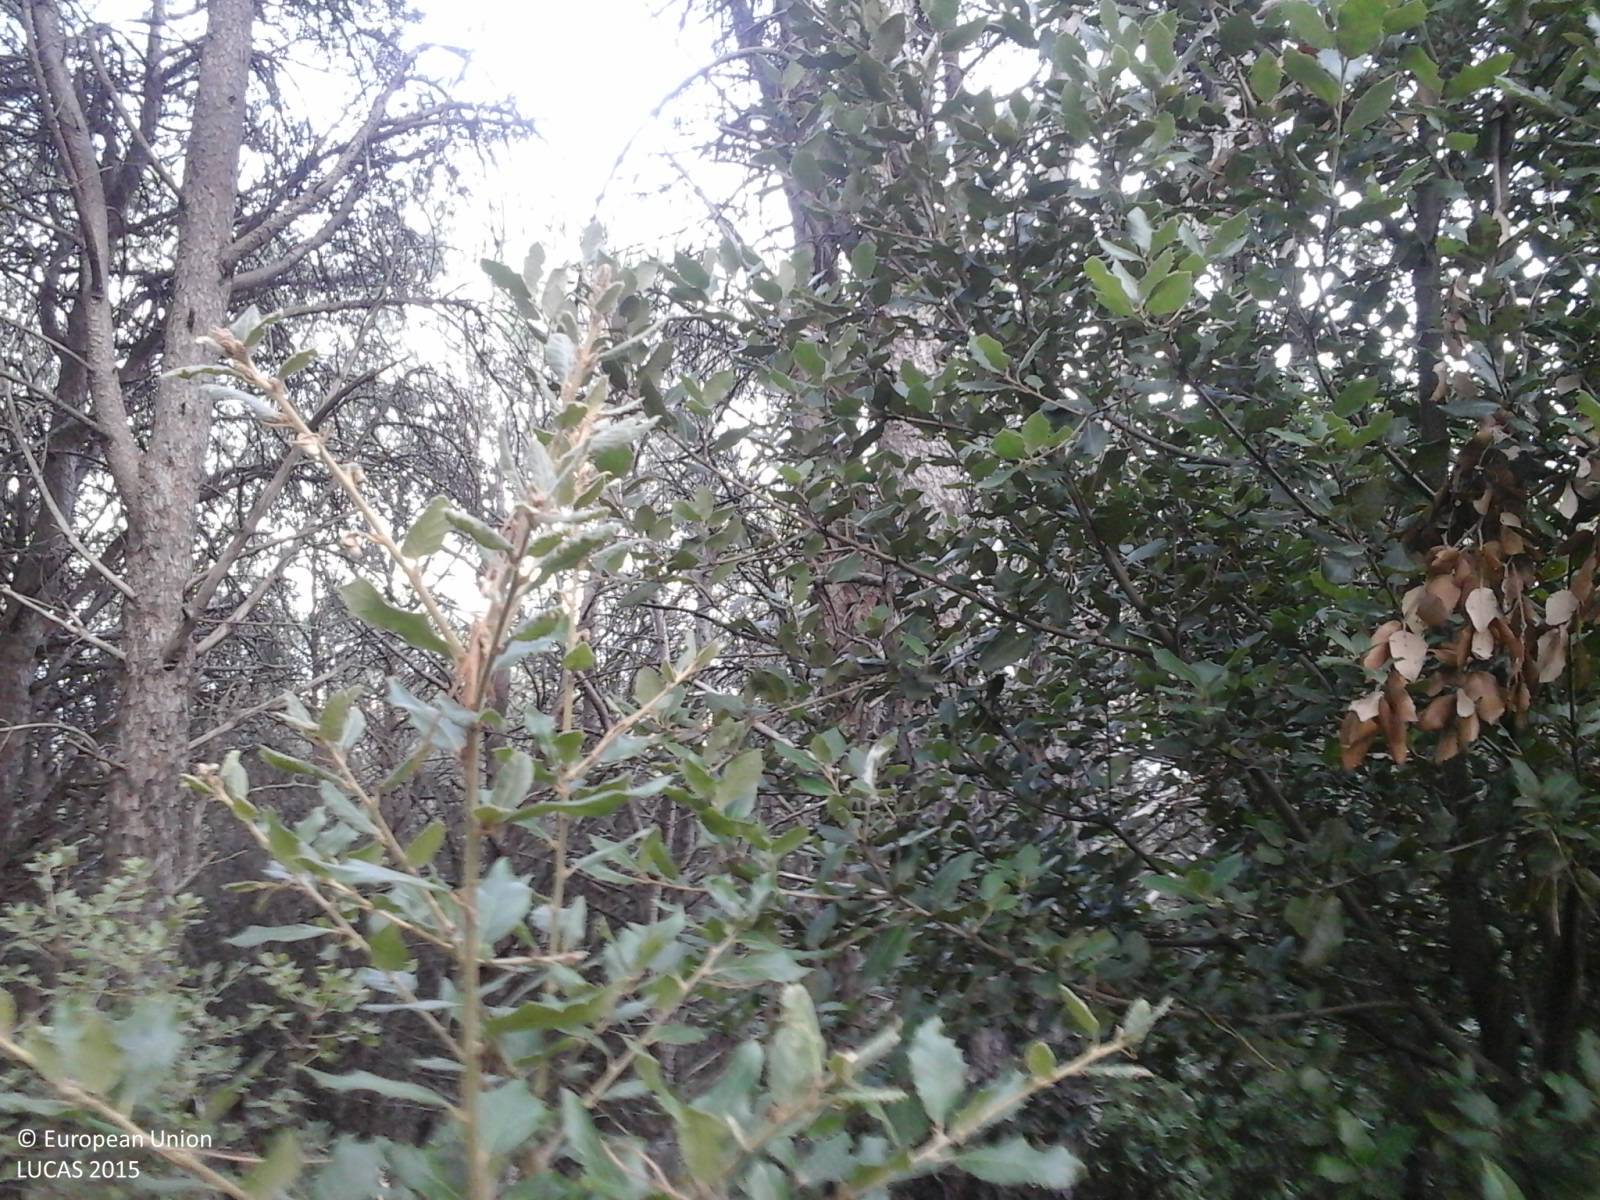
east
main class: Woodland
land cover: Pine dominated coniferous woodland
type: coniferous forest of the mediterranean region
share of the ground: > 75 %
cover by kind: coniferous forest trees 70 %, shrubs 15 %, broadleaved forest trees 5 %, herbaceous plants 5 %, unconsolidated bare surface 5 %
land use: Semi-natural and natural areas not in use
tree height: > 5 m
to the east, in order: Pine dominated coniferous woodland; Tracks; Pine dominated coniferous woodland; Artificial constructions in urban areas
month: September
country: IT
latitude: 39.9222
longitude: 9.5230
